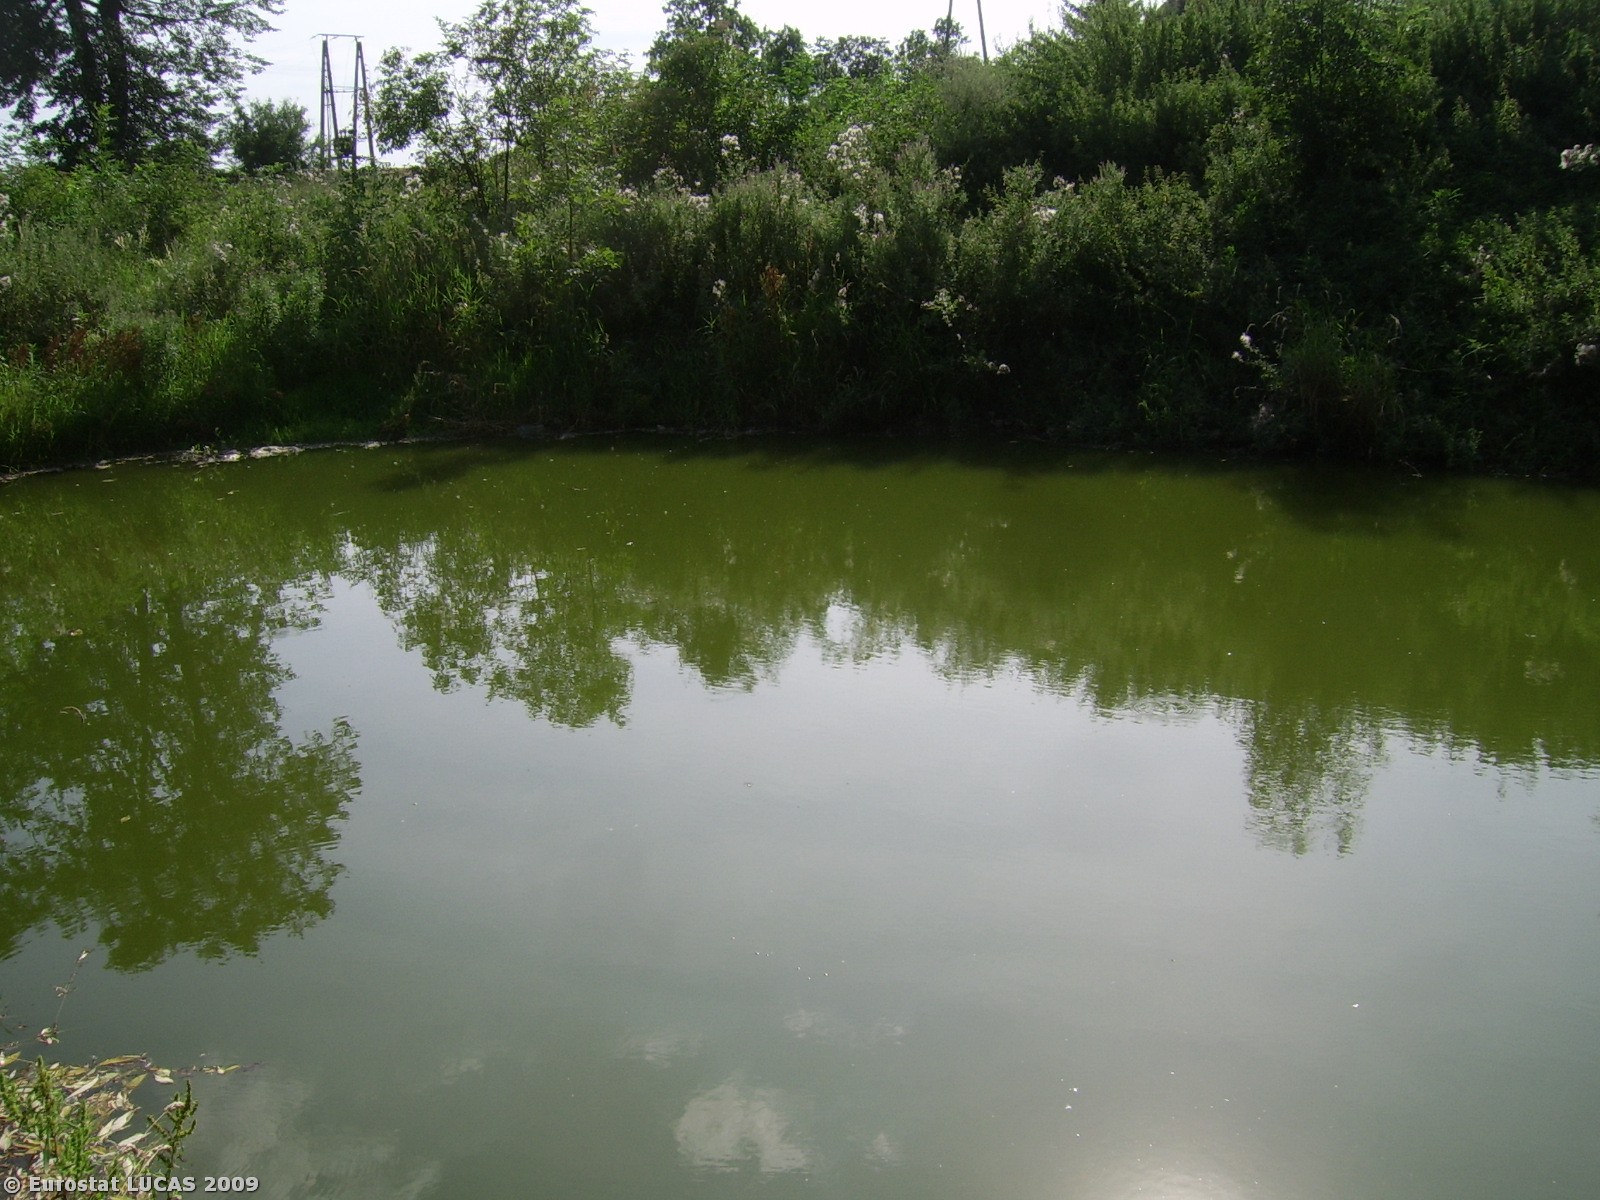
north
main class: Woodland
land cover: Broadleaved woodland
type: mesophytic deciduous forest
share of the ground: > 75 %
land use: Unused
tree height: > 5 m
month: August
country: PL
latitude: 53.2092
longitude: 18.7800
